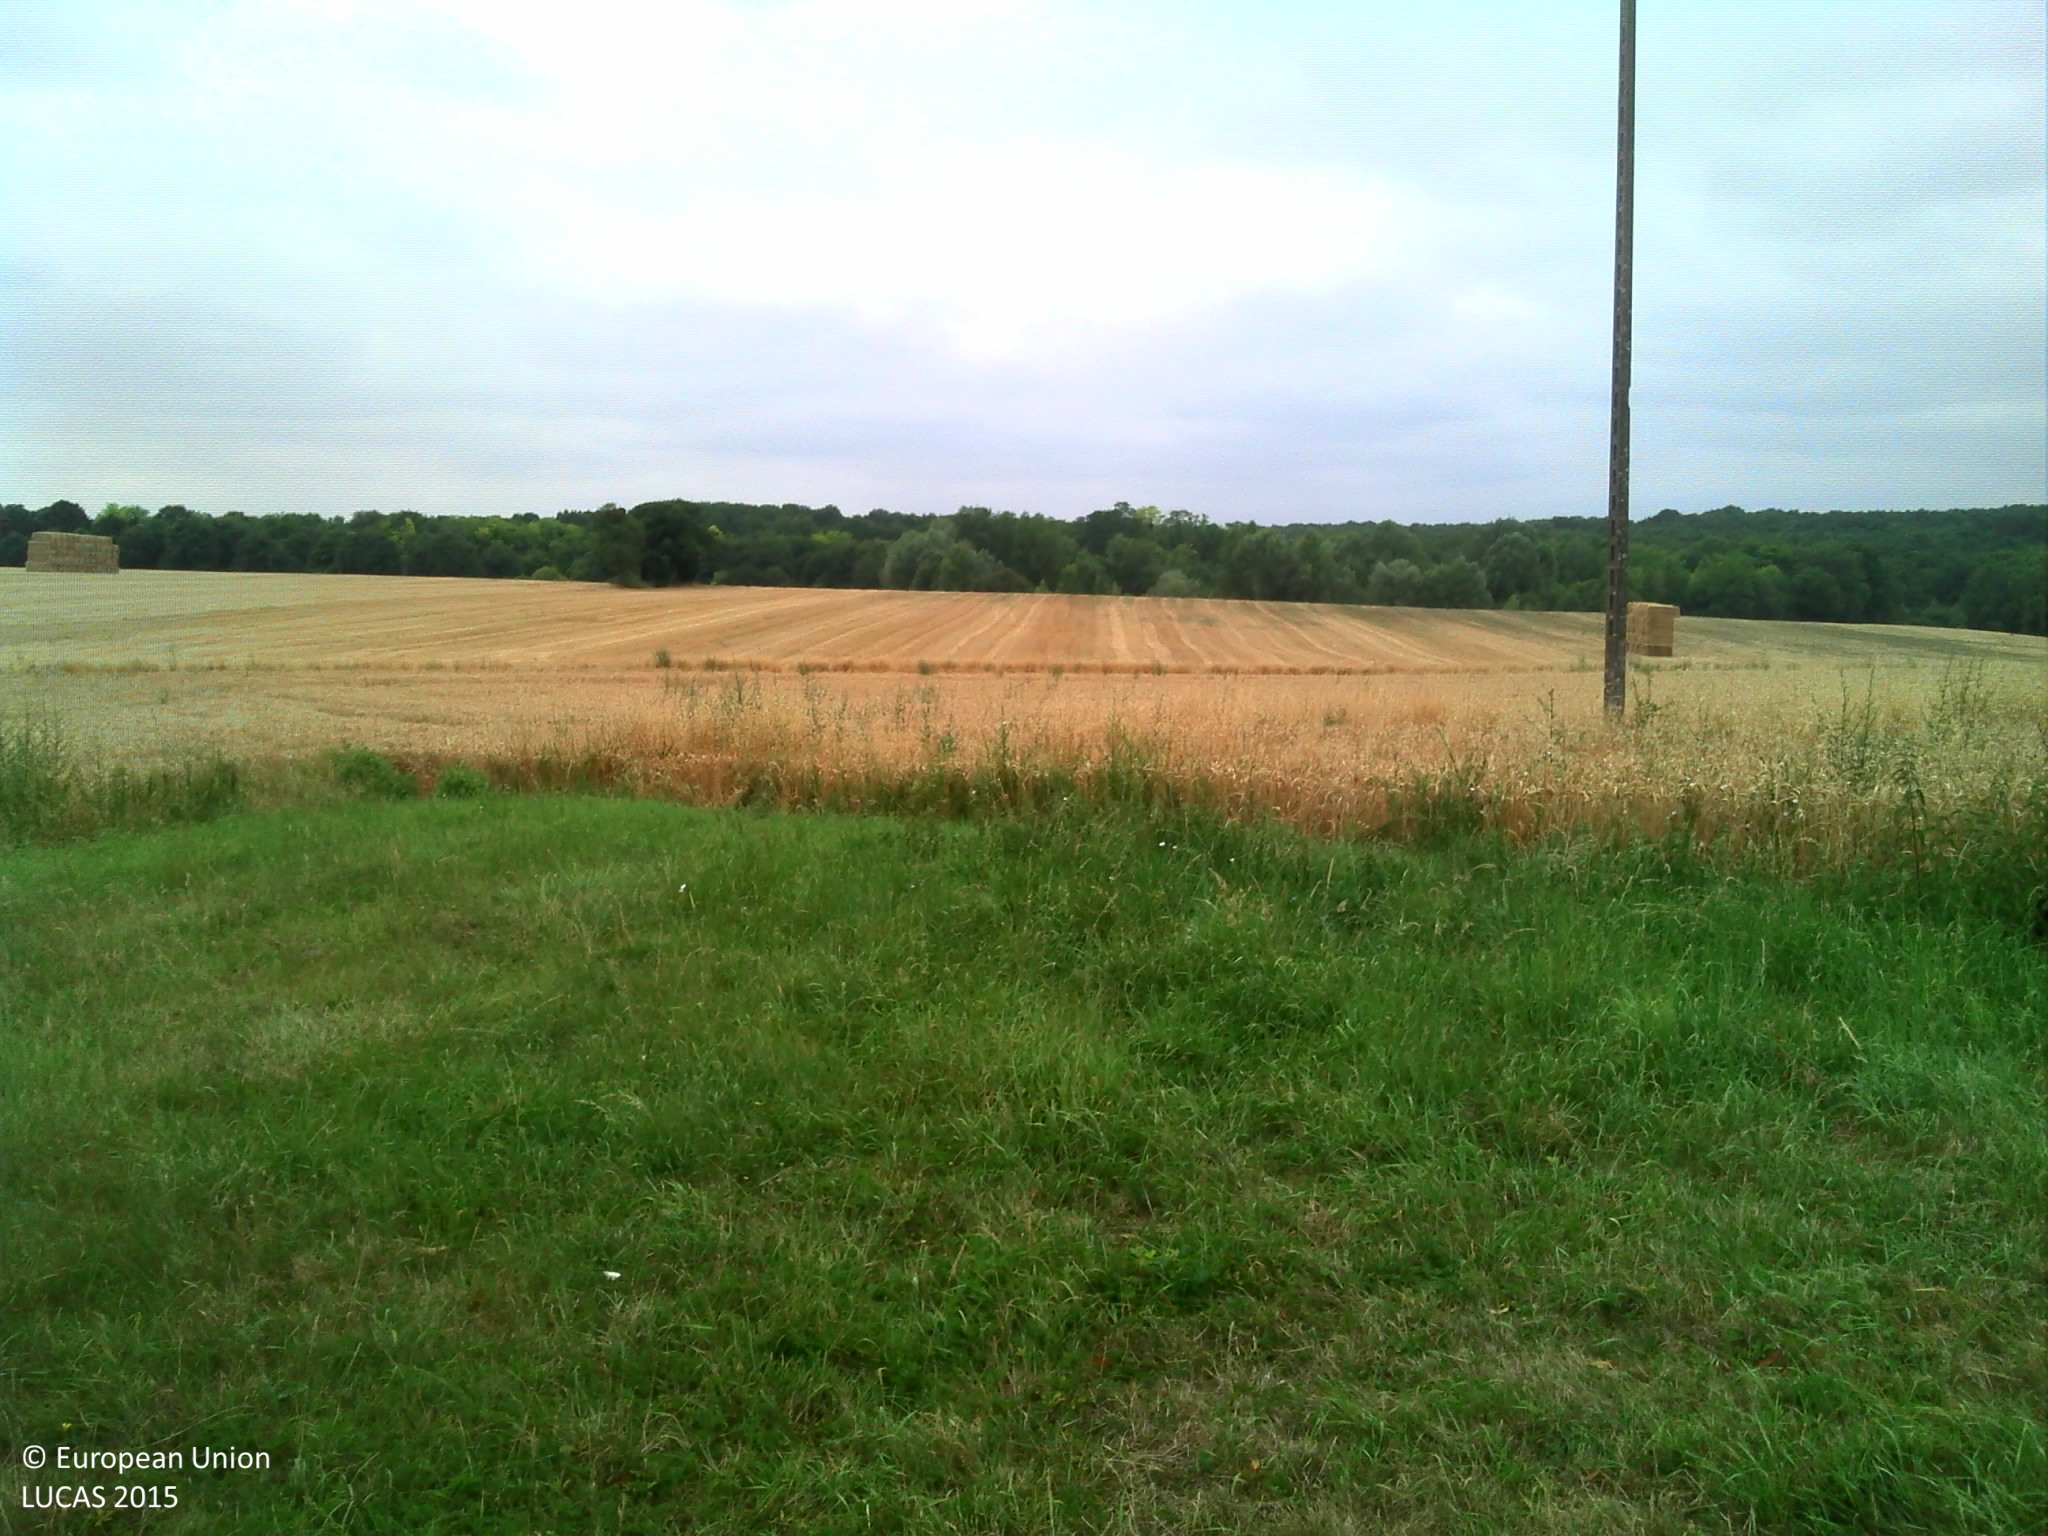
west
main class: Grassland
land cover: Grassland without tree/shrub cover
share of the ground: > 75 %
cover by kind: herbaceous plants 100 %
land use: Agriculture (excluding fallow land and kitchen gardens)
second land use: Residential
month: July
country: FR
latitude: 47.3265
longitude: 0.3318
